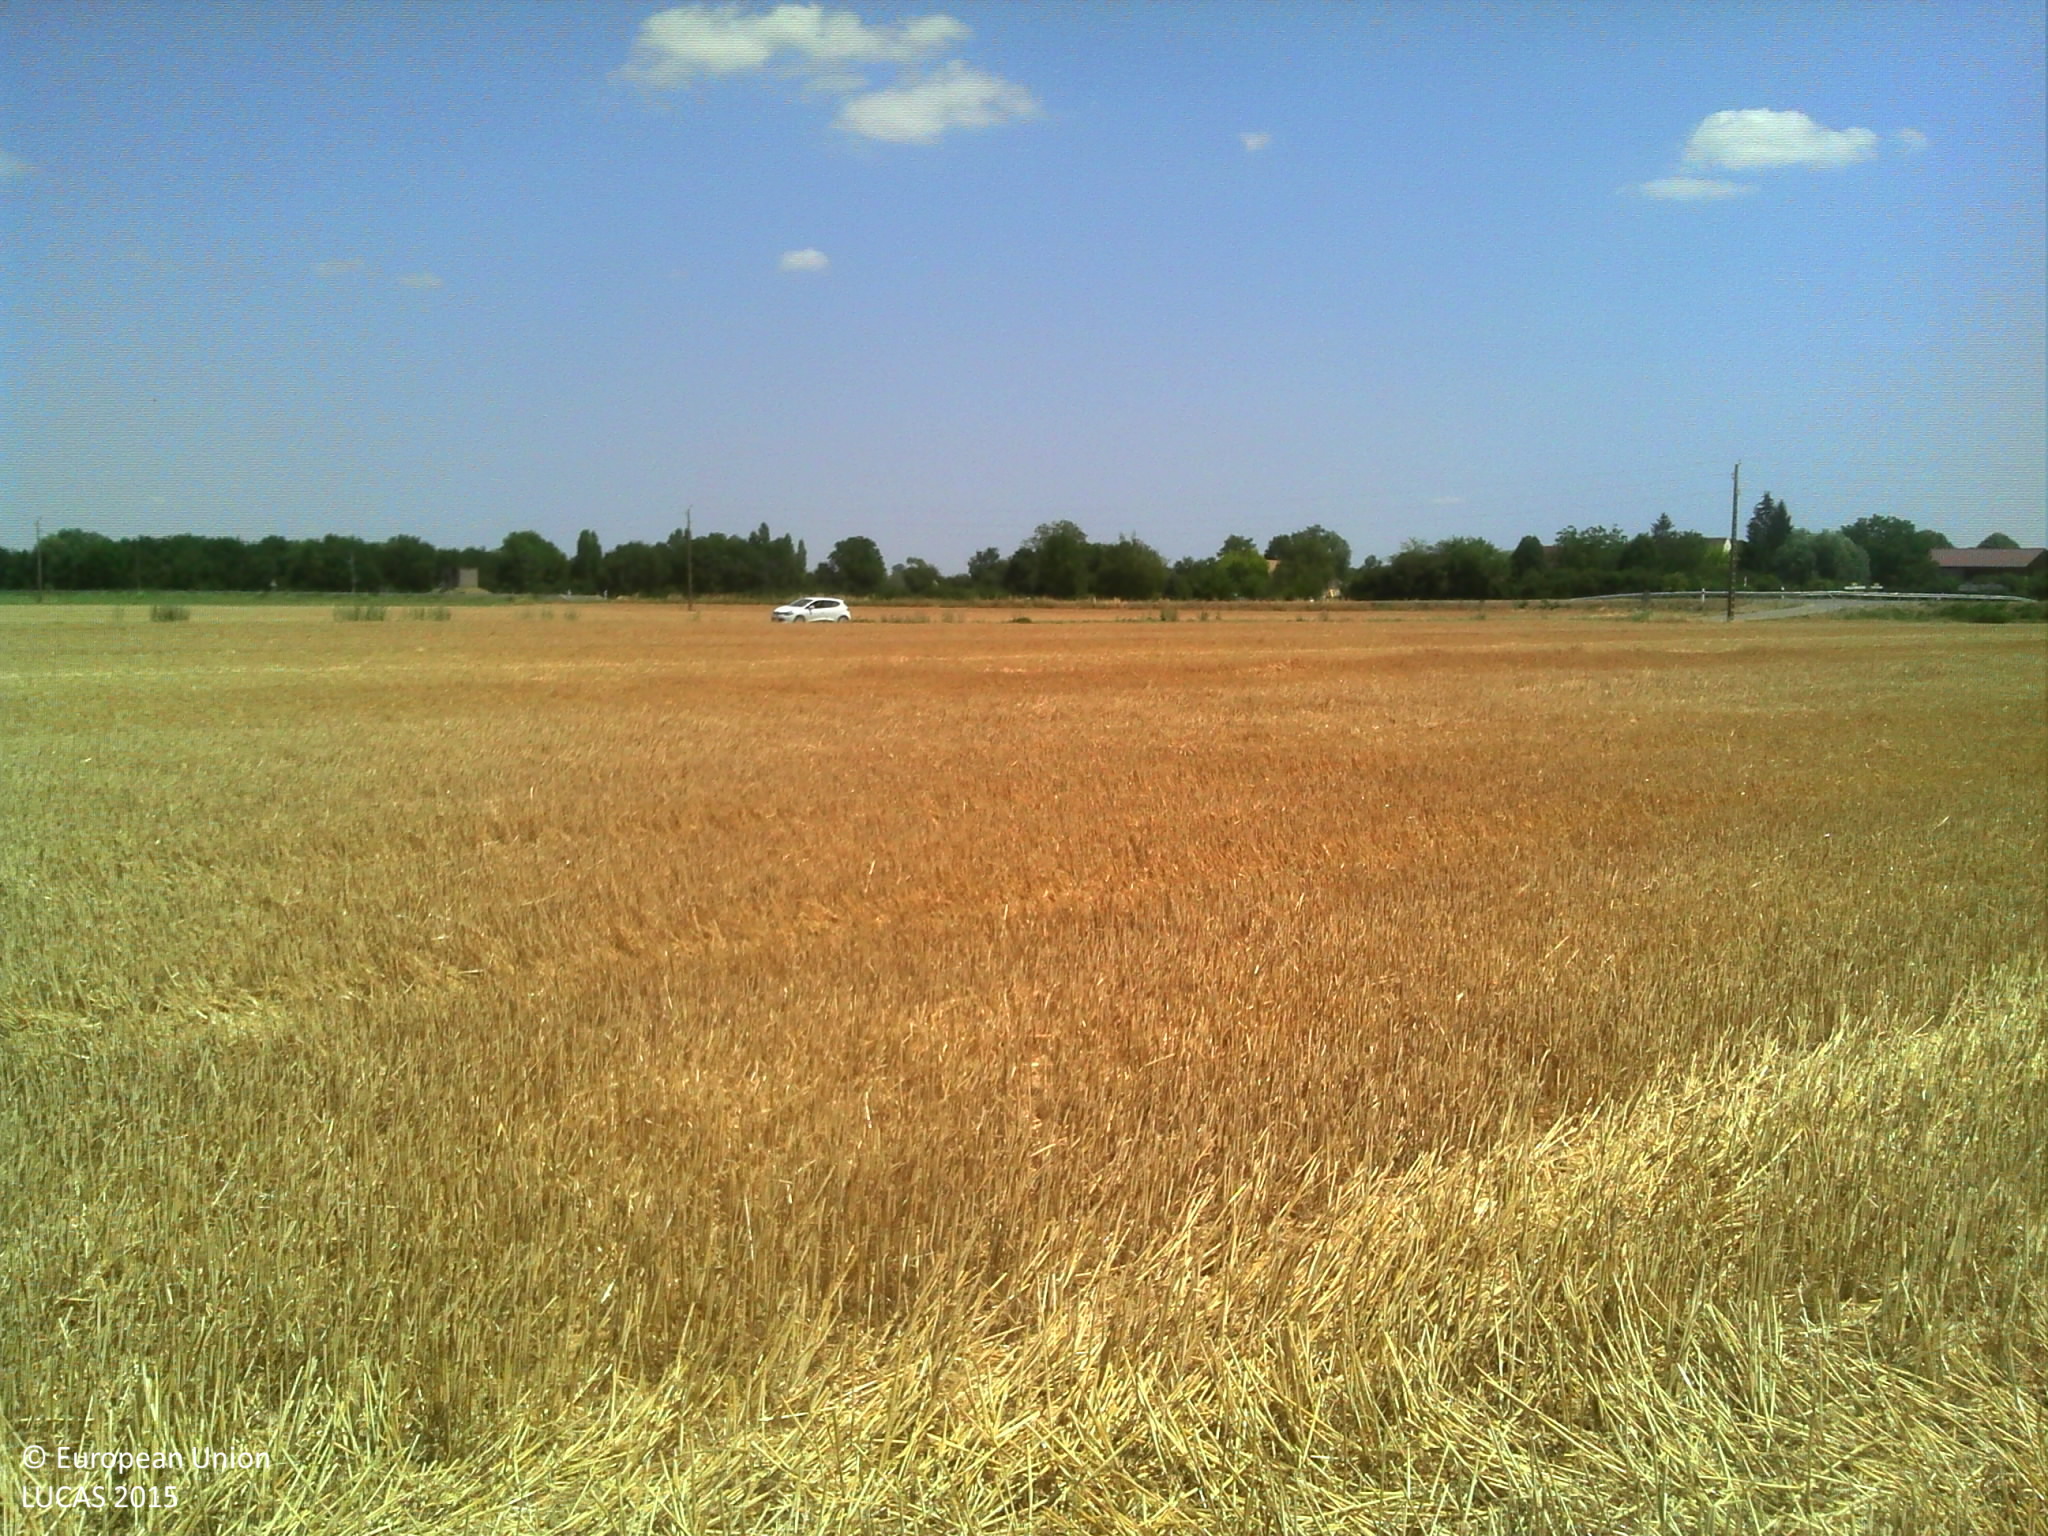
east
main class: Cropland
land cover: Common wheat
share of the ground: > 75 %
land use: Agriculture (excluding fallow land and kitchen gardens)
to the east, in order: Common wheat; Grass margins; Paved roads, cycling and walking lanes; Grass margins; Common wheat; Grass margins; Paved roads, cycling and walking lanes; Grass margins; Temporary grasslands
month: July
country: FR
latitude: 46.9055
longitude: 5.0784
